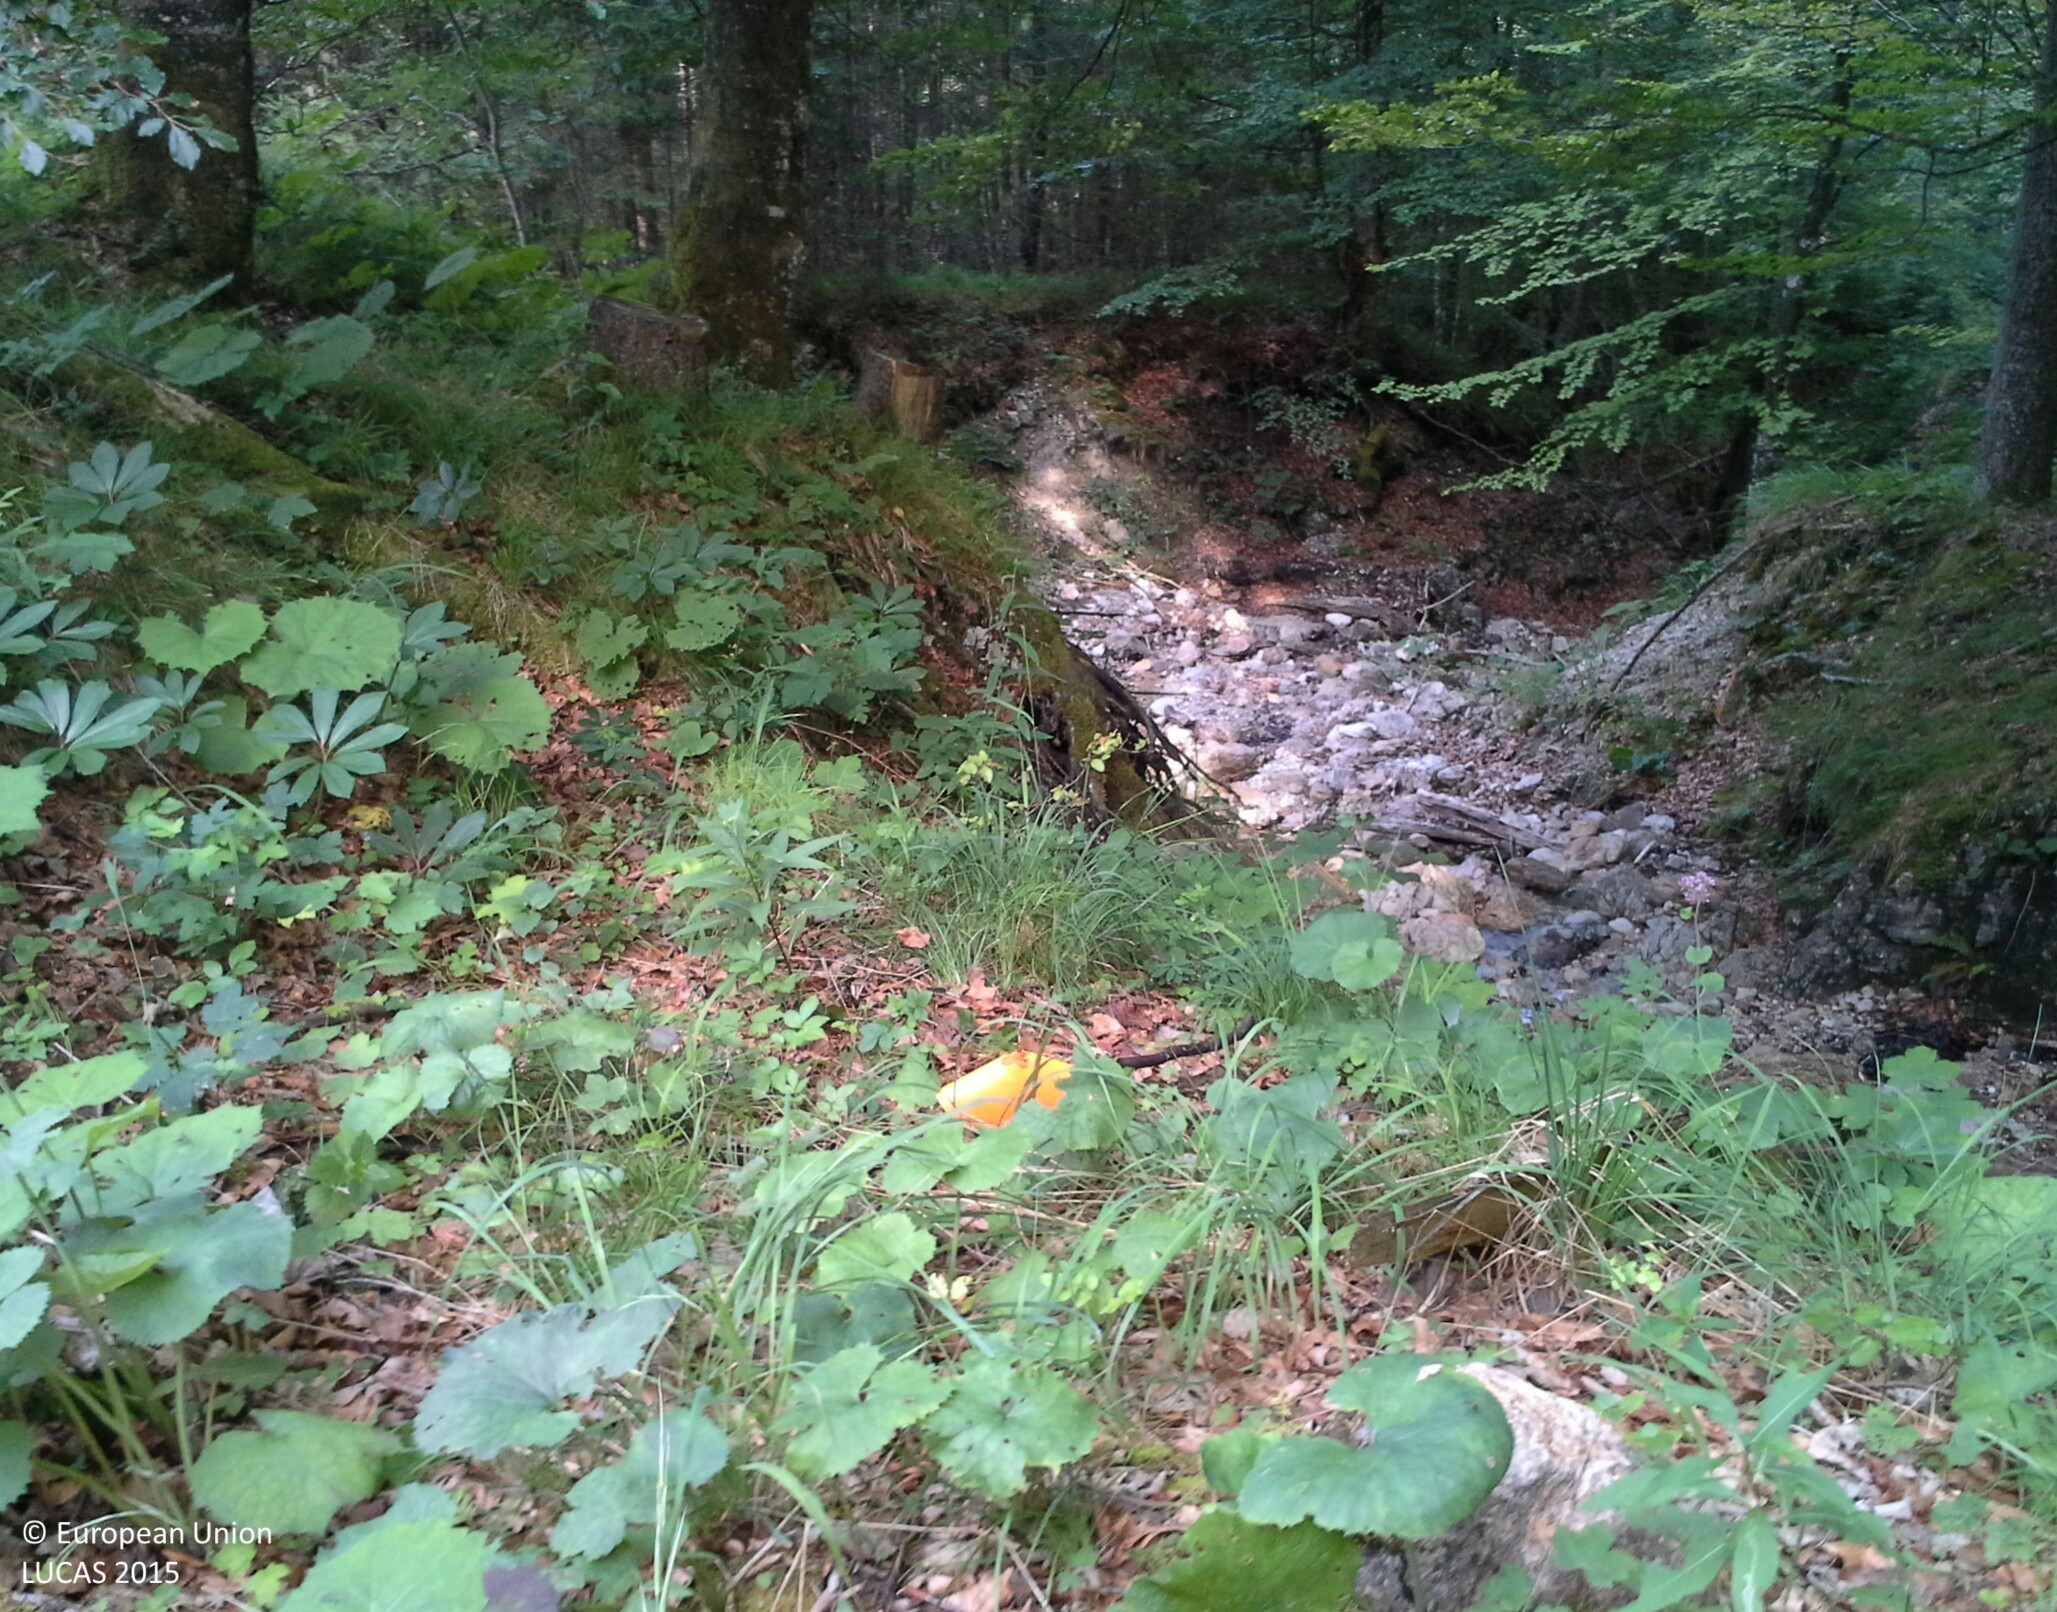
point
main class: Woodland
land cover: Broadleaved woodland
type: mountainous beech forest
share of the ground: > 75 %
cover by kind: broadleaved forest trees 90 %, coniferous forest trees 5 %, shrubs 5 %
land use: Forestry
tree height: > 5 m
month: July
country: AT
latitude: 47.7541
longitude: 14.0143
